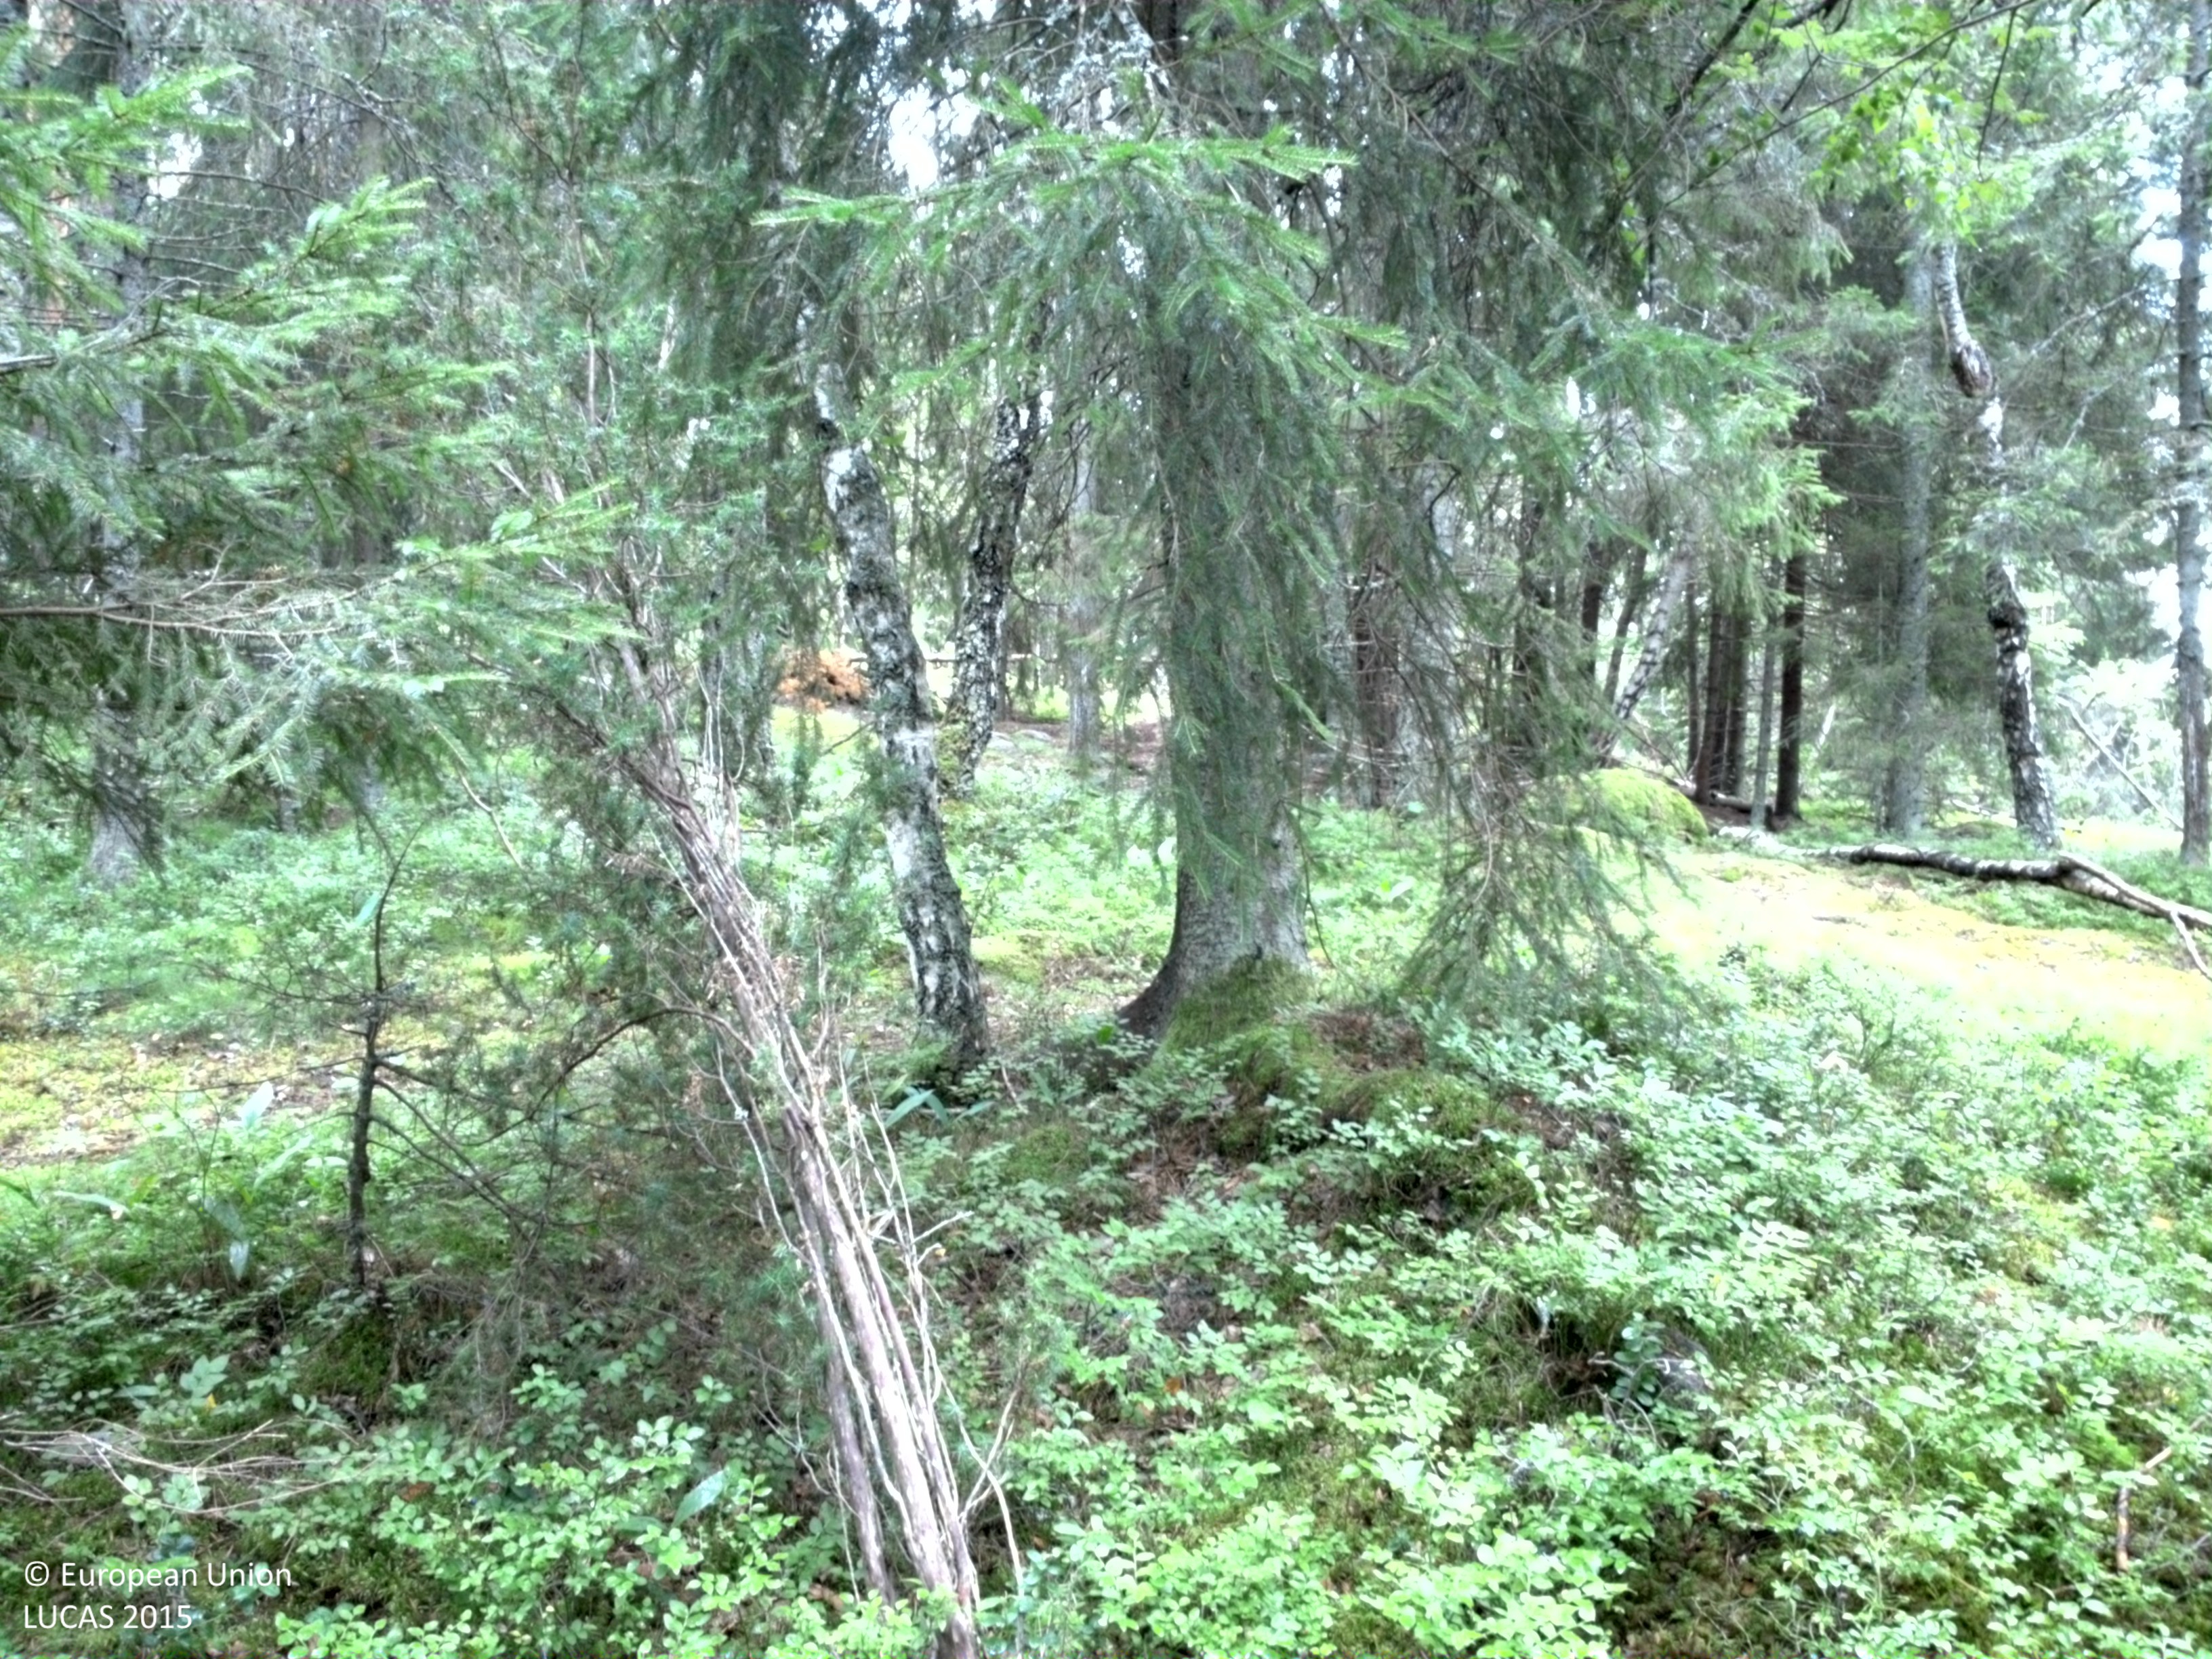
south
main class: Woodland
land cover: Spruce dominated mixed woodland
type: boreal forest
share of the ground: 50 - 75 %
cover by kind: coniferous forest trees 45 %, lichens and mosses 30 %, broadleaved forest trees 15 %, shrubs 10 %
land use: Forestry
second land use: Amenities, museums, leisure
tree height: > 5 m
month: July
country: SE
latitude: 59.5001
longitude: 18.3190
